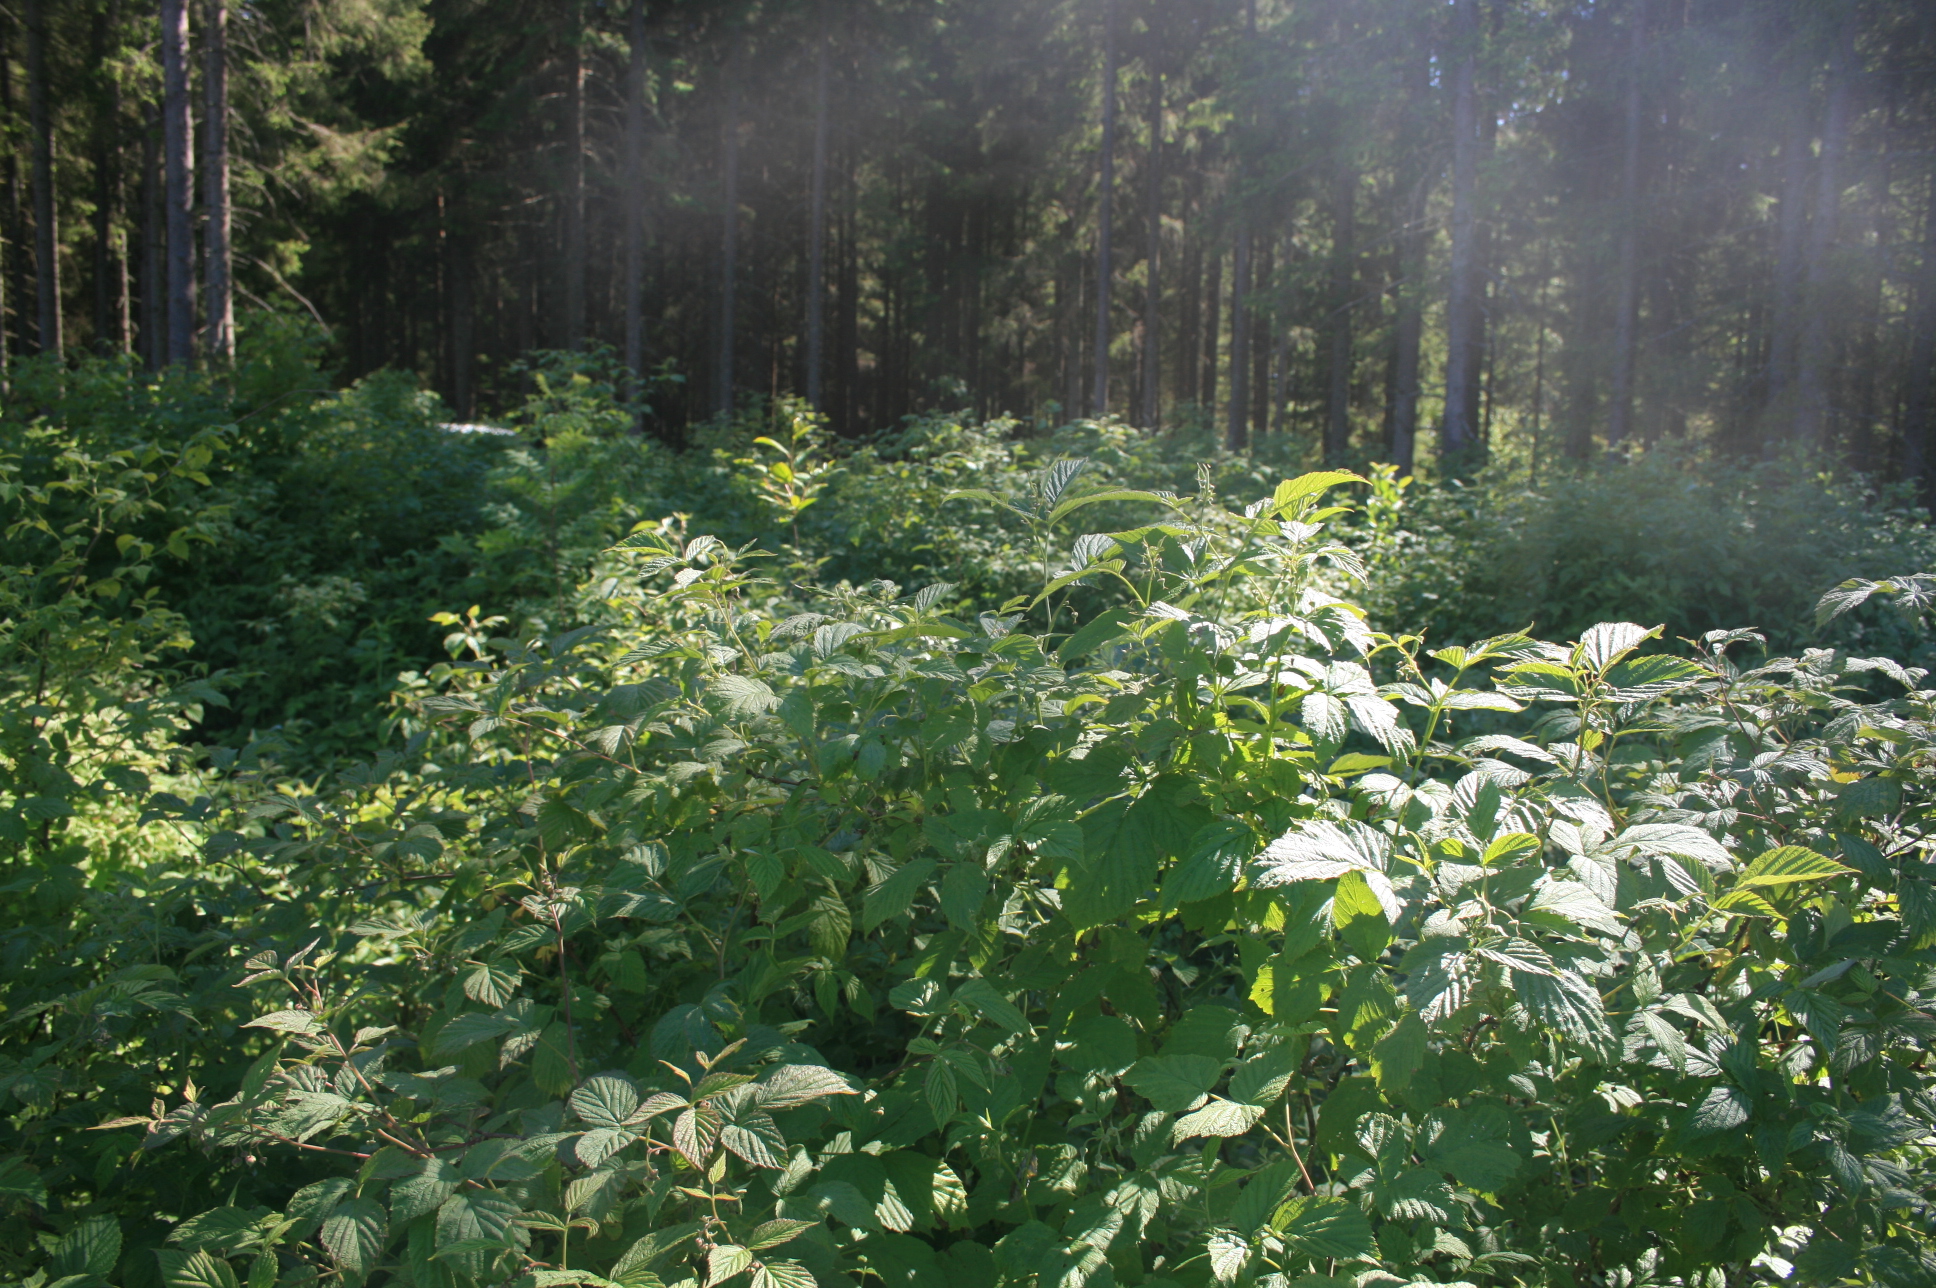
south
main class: Shrubland
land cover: Shrubland with sparse tree cover
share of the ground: > 75 %
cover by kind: shrubs 80 %, herbaceous plants 15 %, broadleaved forest trees 5 %
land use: Forestry
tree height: < 5 m
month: June
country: LT
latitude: 55.8152
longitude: 22.2644
